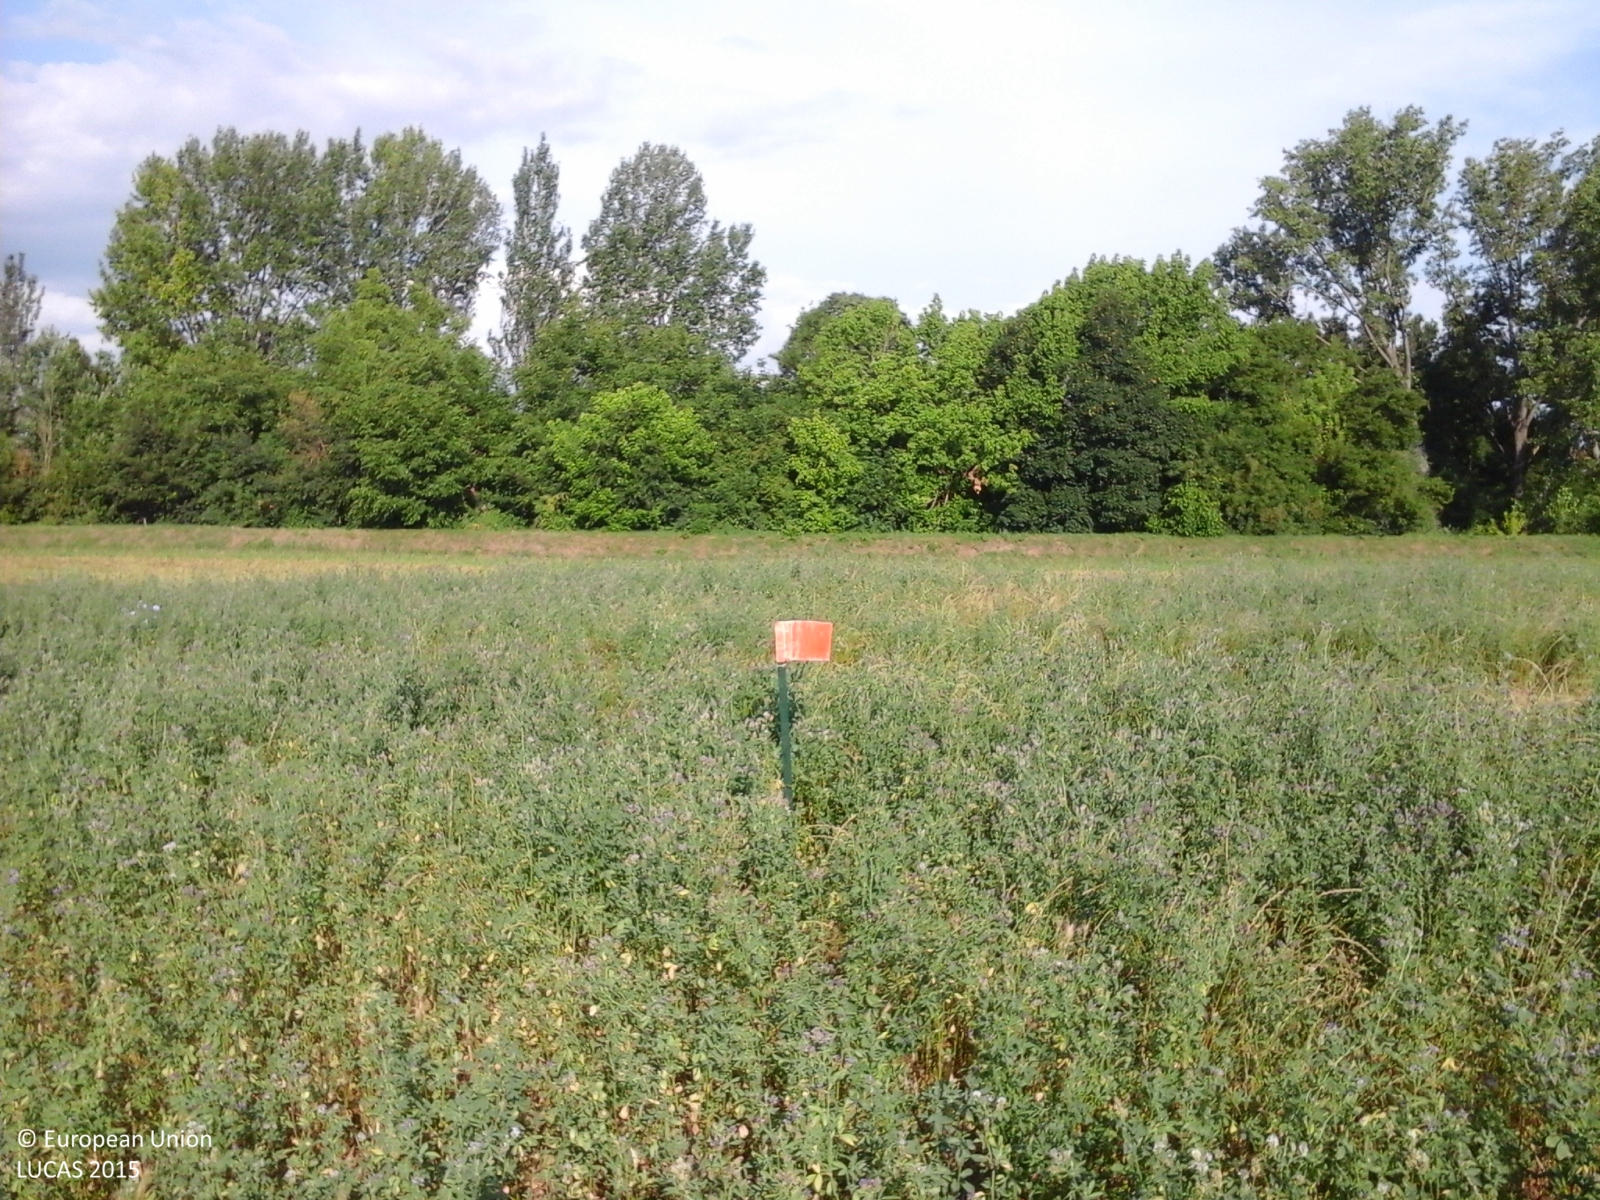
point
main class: Cropland
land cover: Lucerne
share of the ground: > 75 %
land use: Agriculture (excluding fallow land and kitchen gardens)
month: June
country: IT
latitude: 44.6915
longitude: 10.5918
